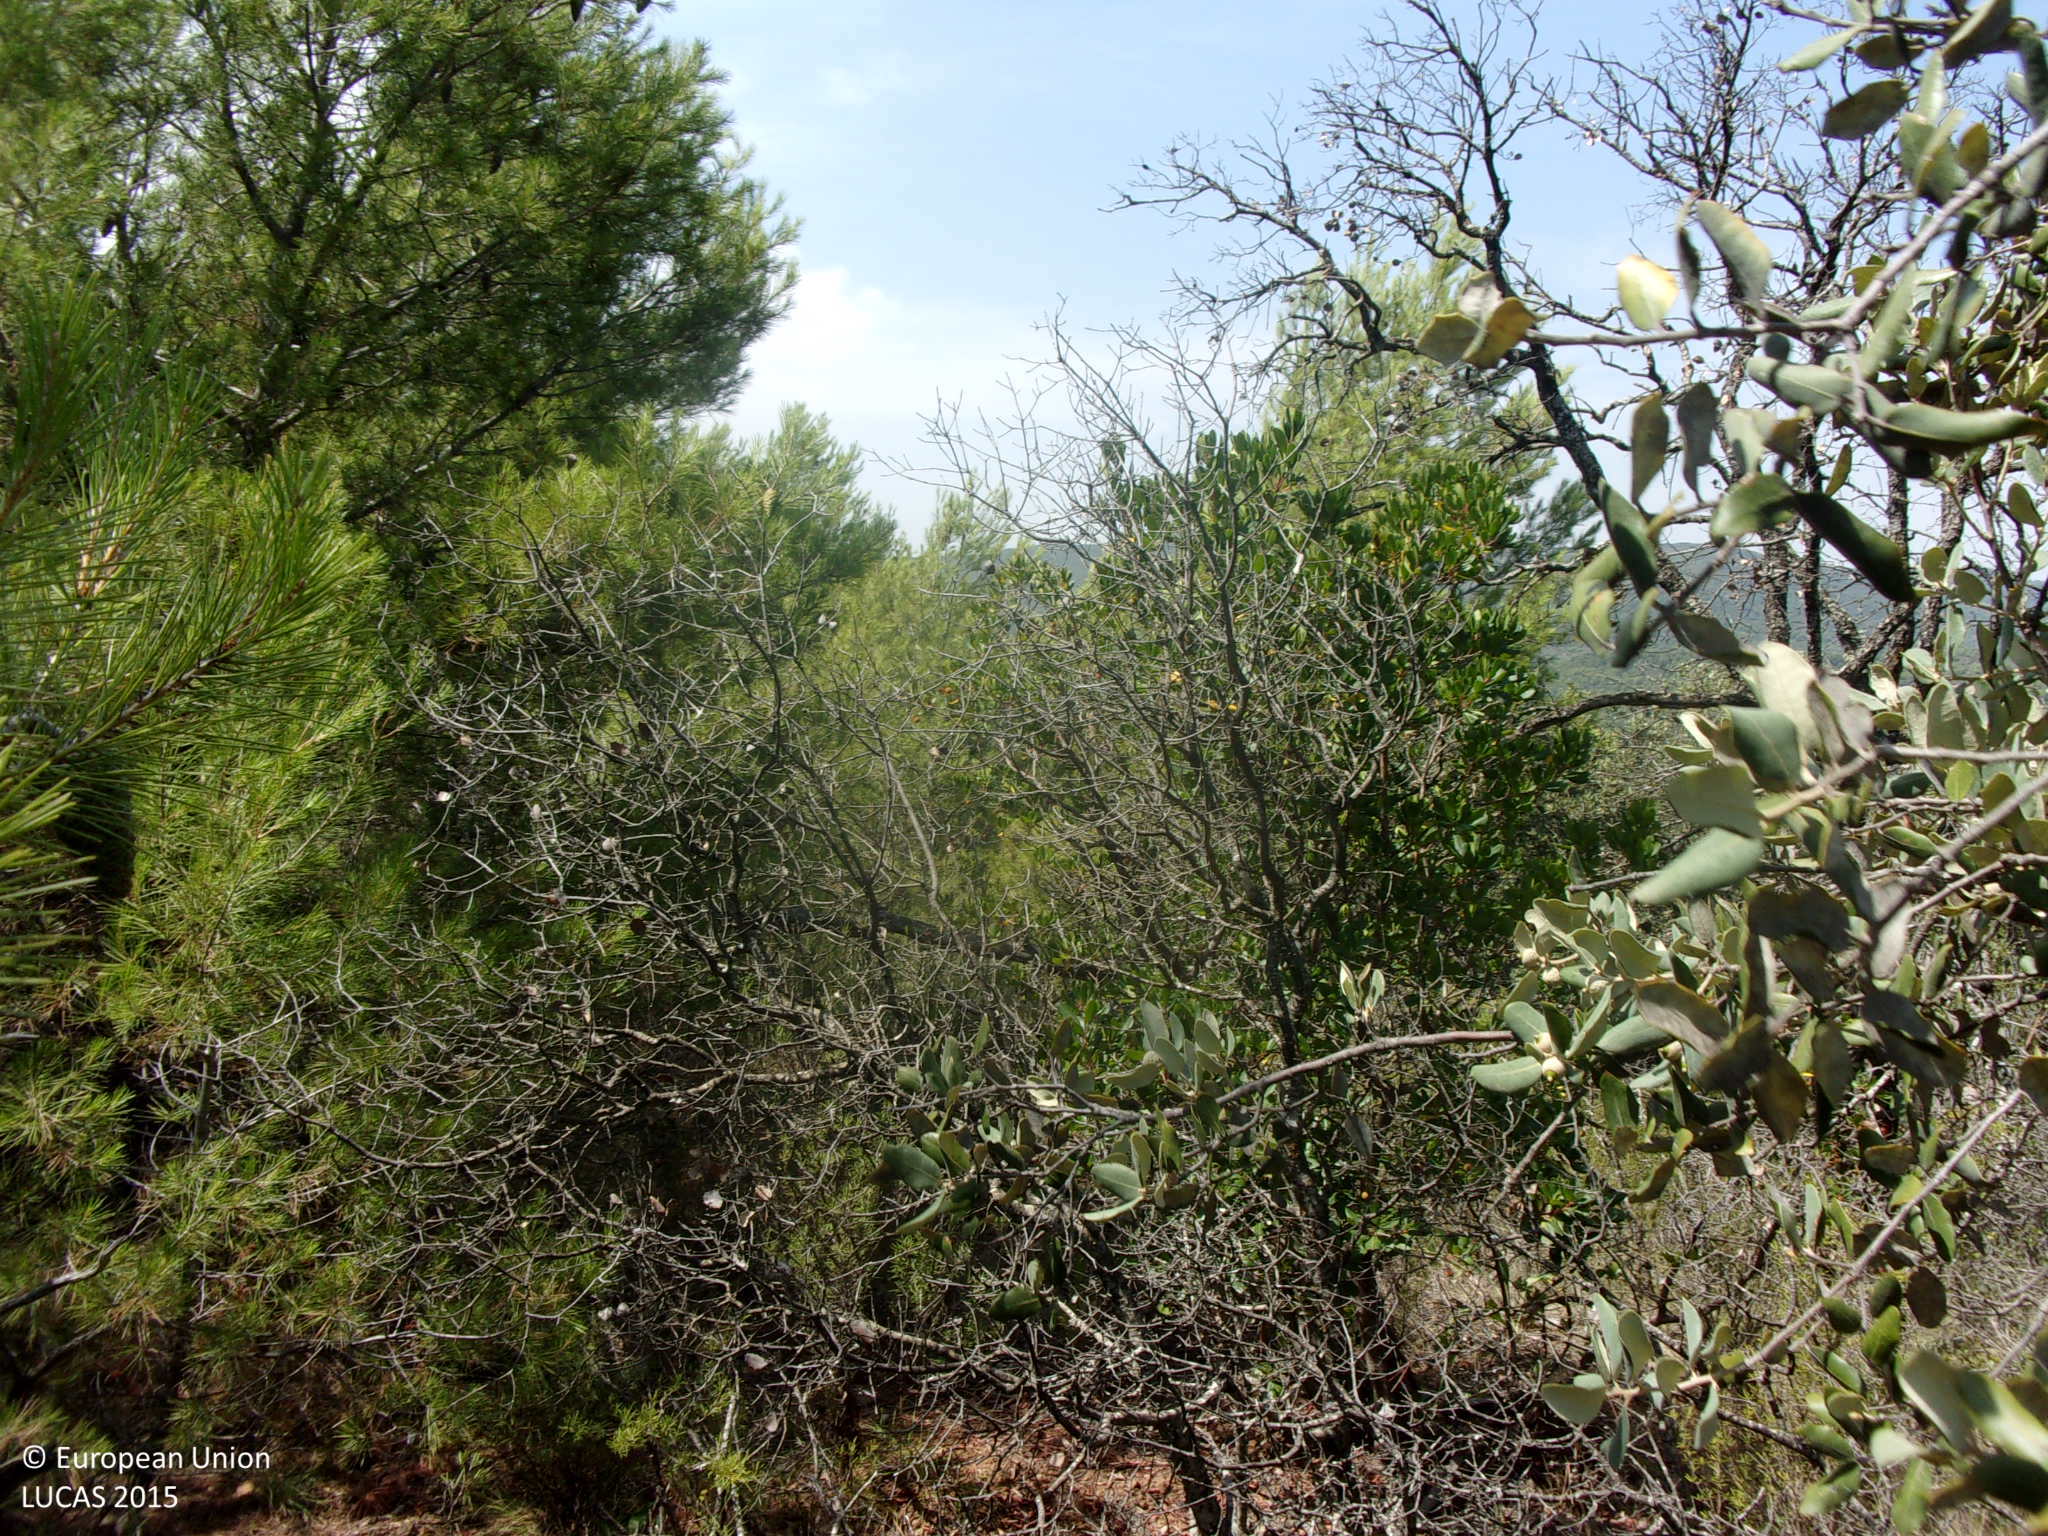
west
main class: Woodland
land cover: Pine dominated mixed woodland
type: coniferous forest of the mediterranean region
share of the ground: > 75 %
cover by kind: coniferous forest trees 60 %, broadleaved forest trees 30 %, shrubs 10 %
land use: Forestry
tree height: < 5 m
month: August
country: ES
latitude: 42.4810
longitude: -1.4079
